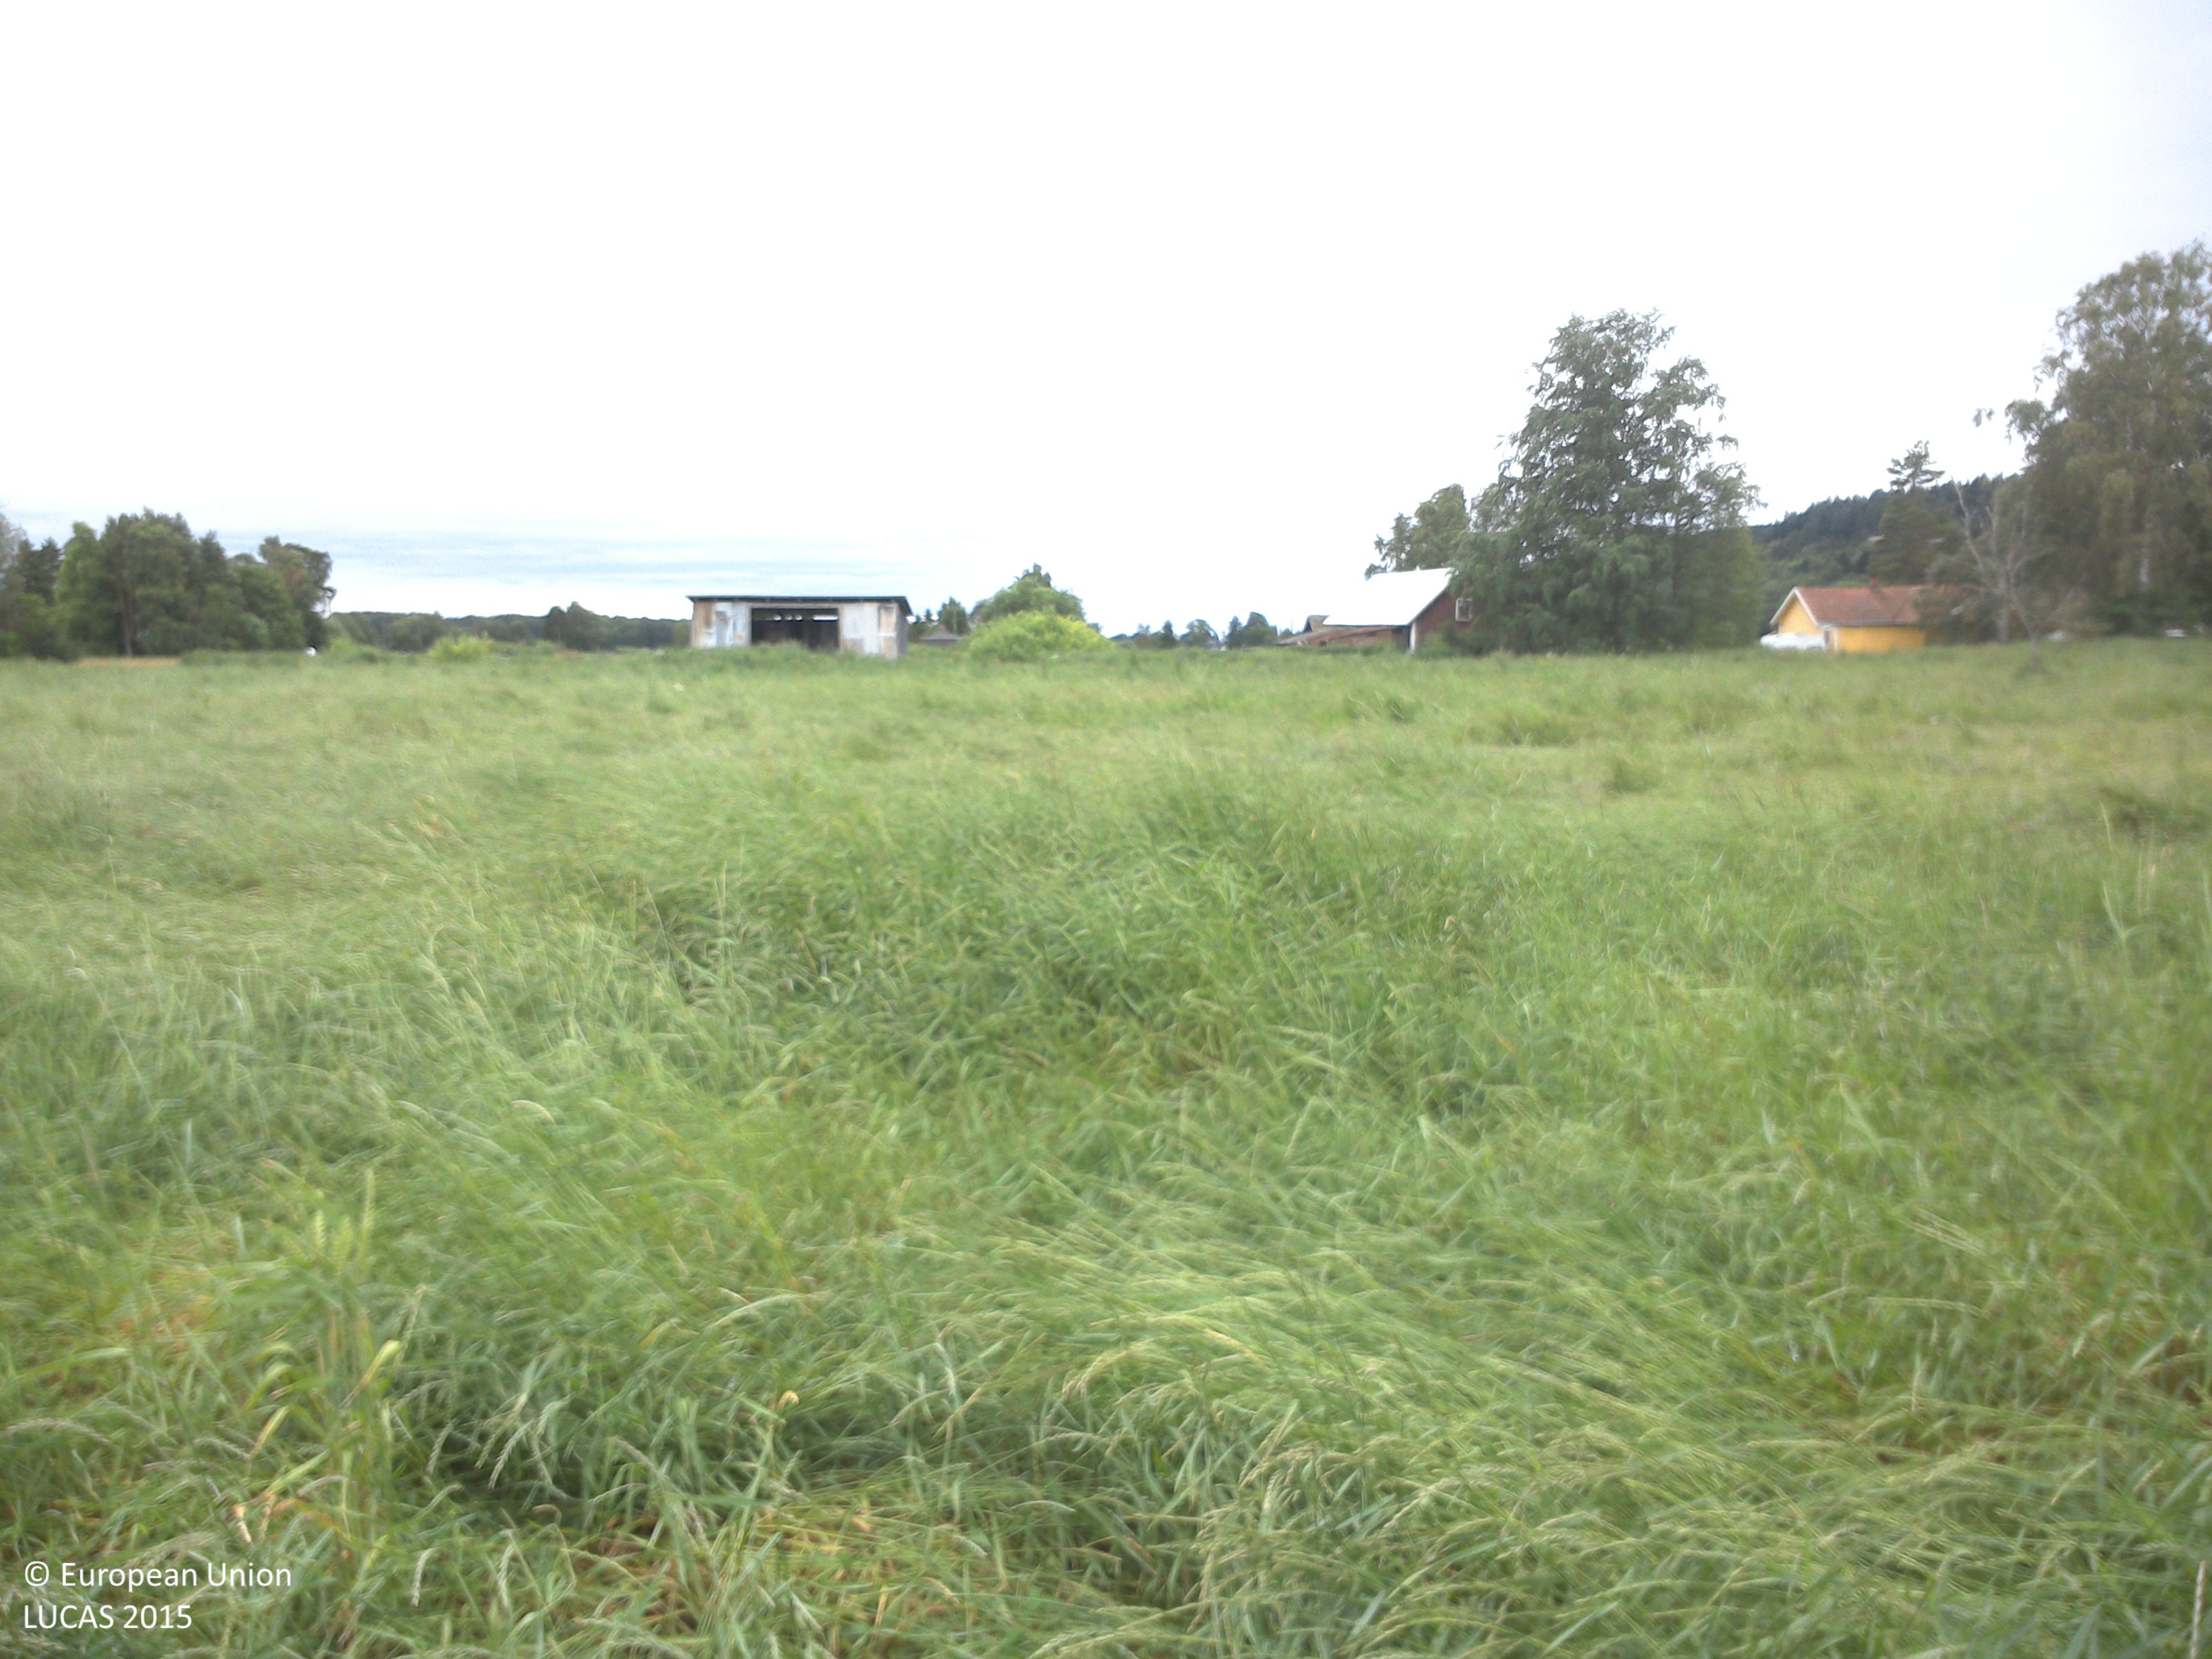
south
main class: Cropland
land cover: Temporary grasslands
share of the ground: > 75 %
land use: Agriculture (excluding fallow land and kitchen gardens)
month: July
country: SE
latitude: 58.3180
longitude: 14.6885
